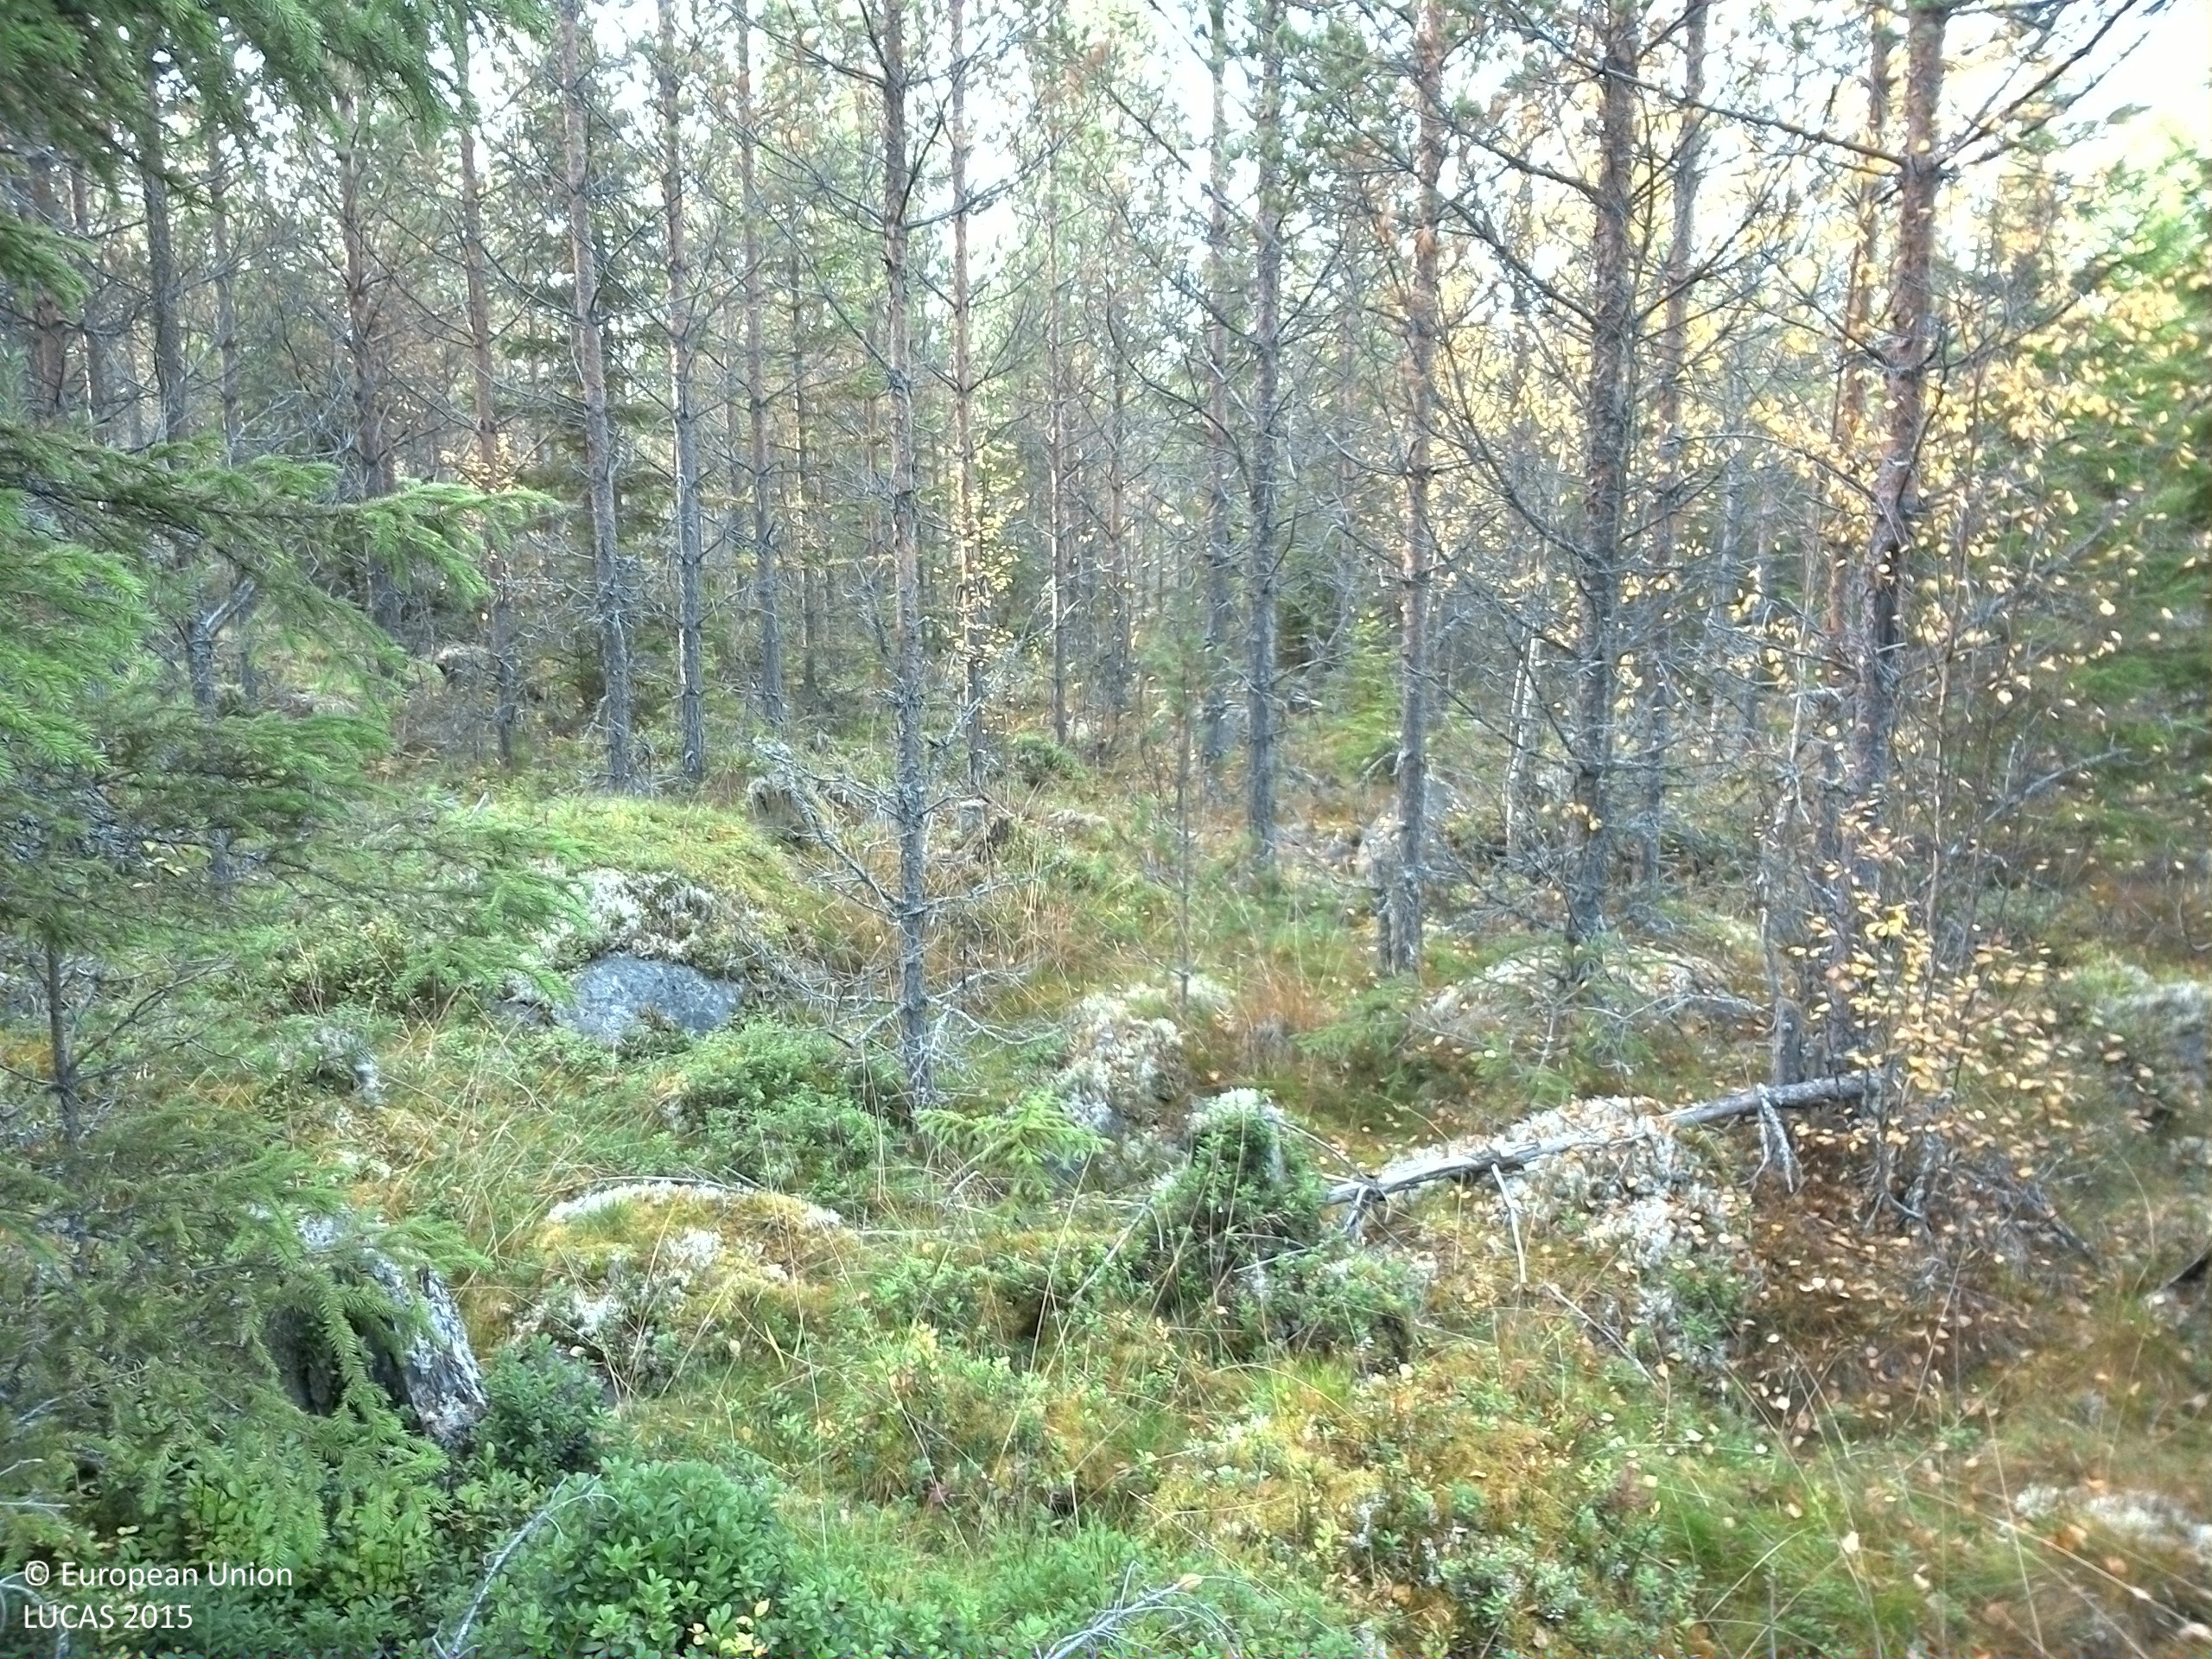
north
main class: Woodland
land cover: Other coniferous woodland
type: boreal forest
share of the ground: 50 - 75 %
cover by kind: coniferous forest trees 55 %, shrubs 25 %, lichens and mosses 10 %, broadleaved forest trees 5 %, consolidated bare surface 5 %
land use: Forestry
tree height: > 5 m
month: October
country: SE
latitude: 61.2805
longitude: 15.0780
